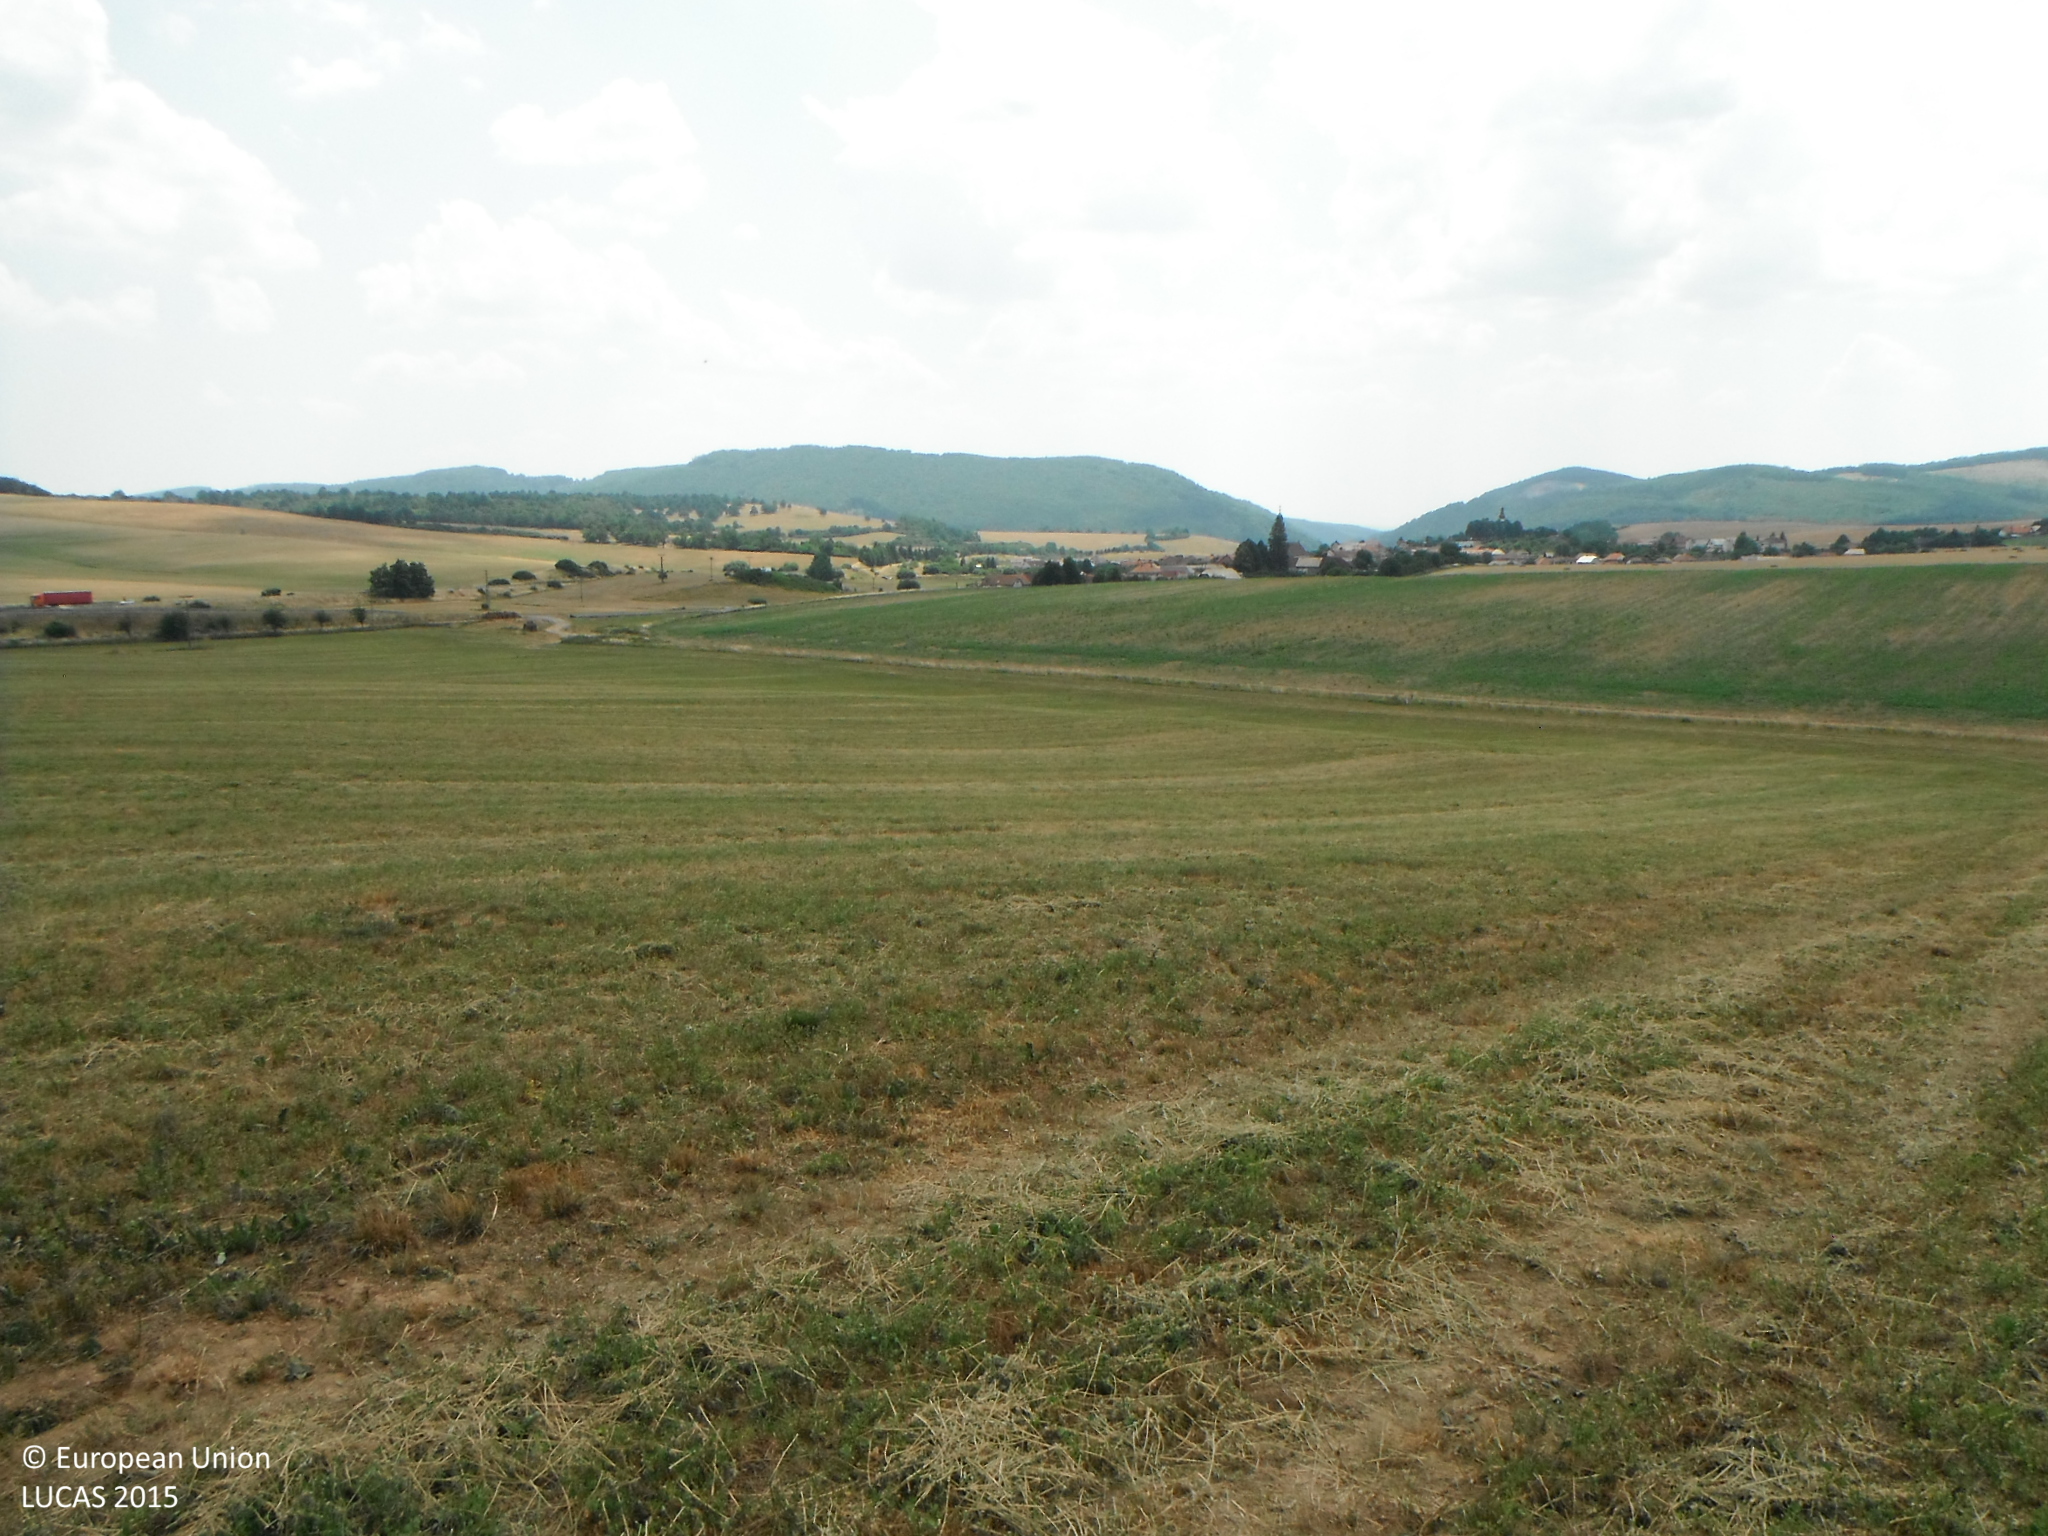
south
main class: Cropland
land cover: Lucerne
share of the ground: > 75 %
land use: Agriculture (excluding fallow land and kitchen gardens)
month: July
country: SK
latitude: 48.4446
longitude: 19.0924
